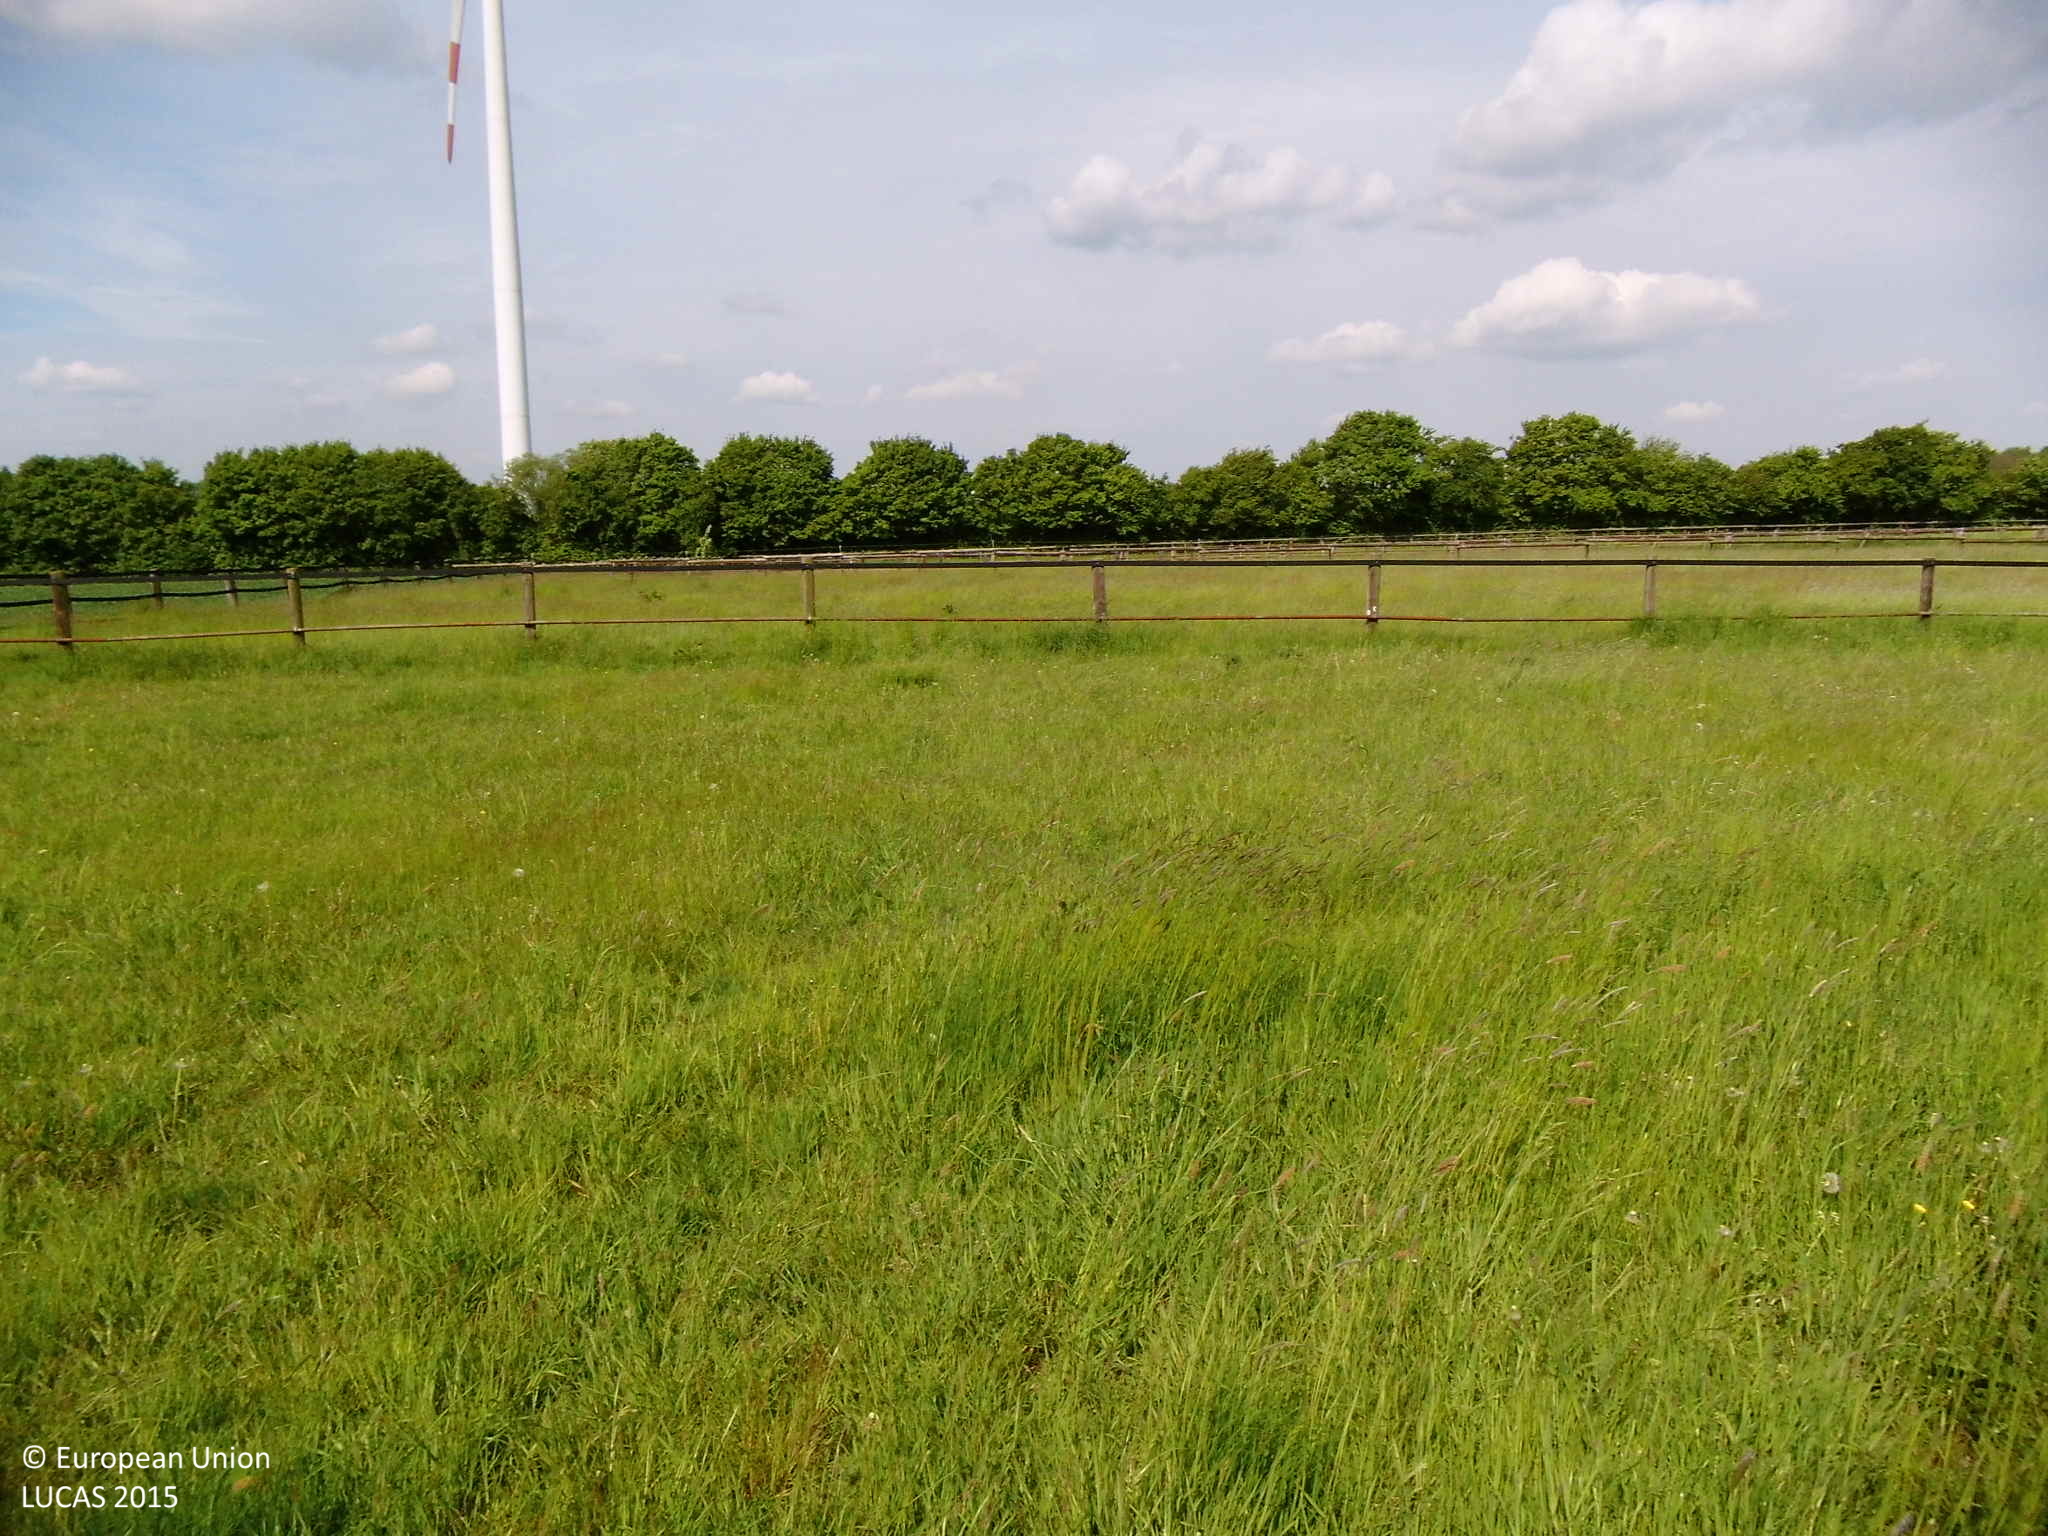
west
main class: Grassland
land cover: Grassland without tree/shrub cover
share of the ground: > 75 %
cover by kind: herbaceous plants 95 %, unconsolidated bare surface 5 %
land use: Agriculture (excluding fallow land and kitchen gardens)
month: May
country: DE
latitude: 51.4677
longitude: 7.3947
